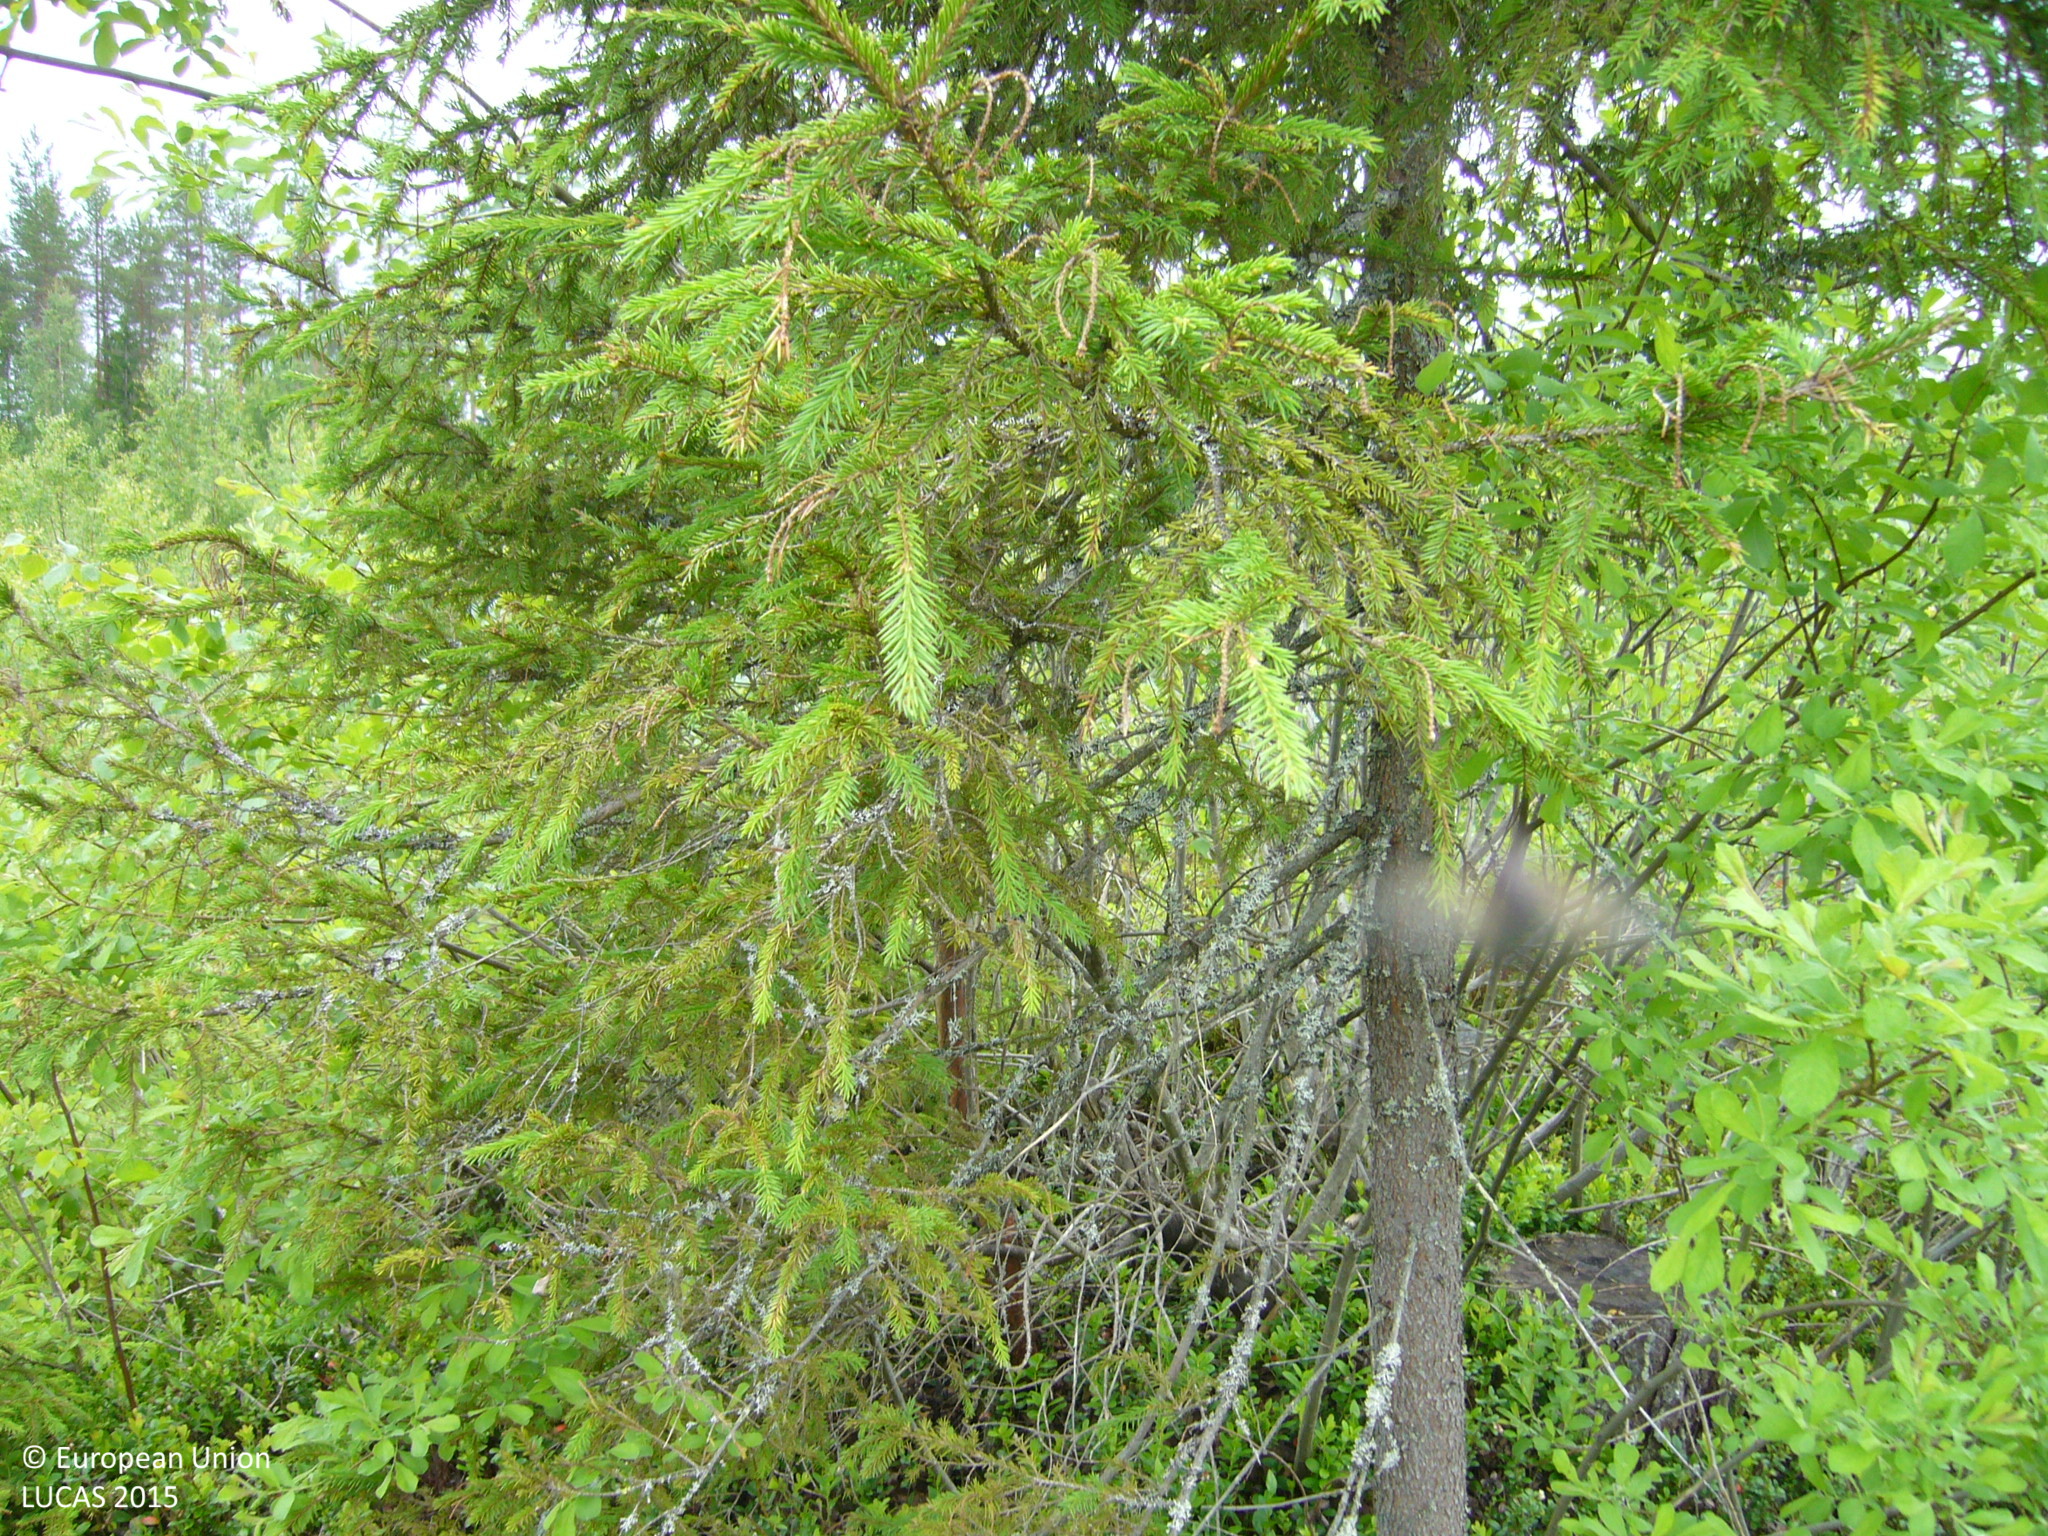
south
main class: Woodland
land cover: Spruce dominated mixed woodland
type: boreal forest
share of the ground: > 75 %
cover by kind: broadleaved forest trees 50 %, coniferous forest trees 25 %, shrubs 25 %
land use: Forestry
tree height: < 5 m
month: July
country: FI
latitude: 63.4285
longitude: 25.8400
